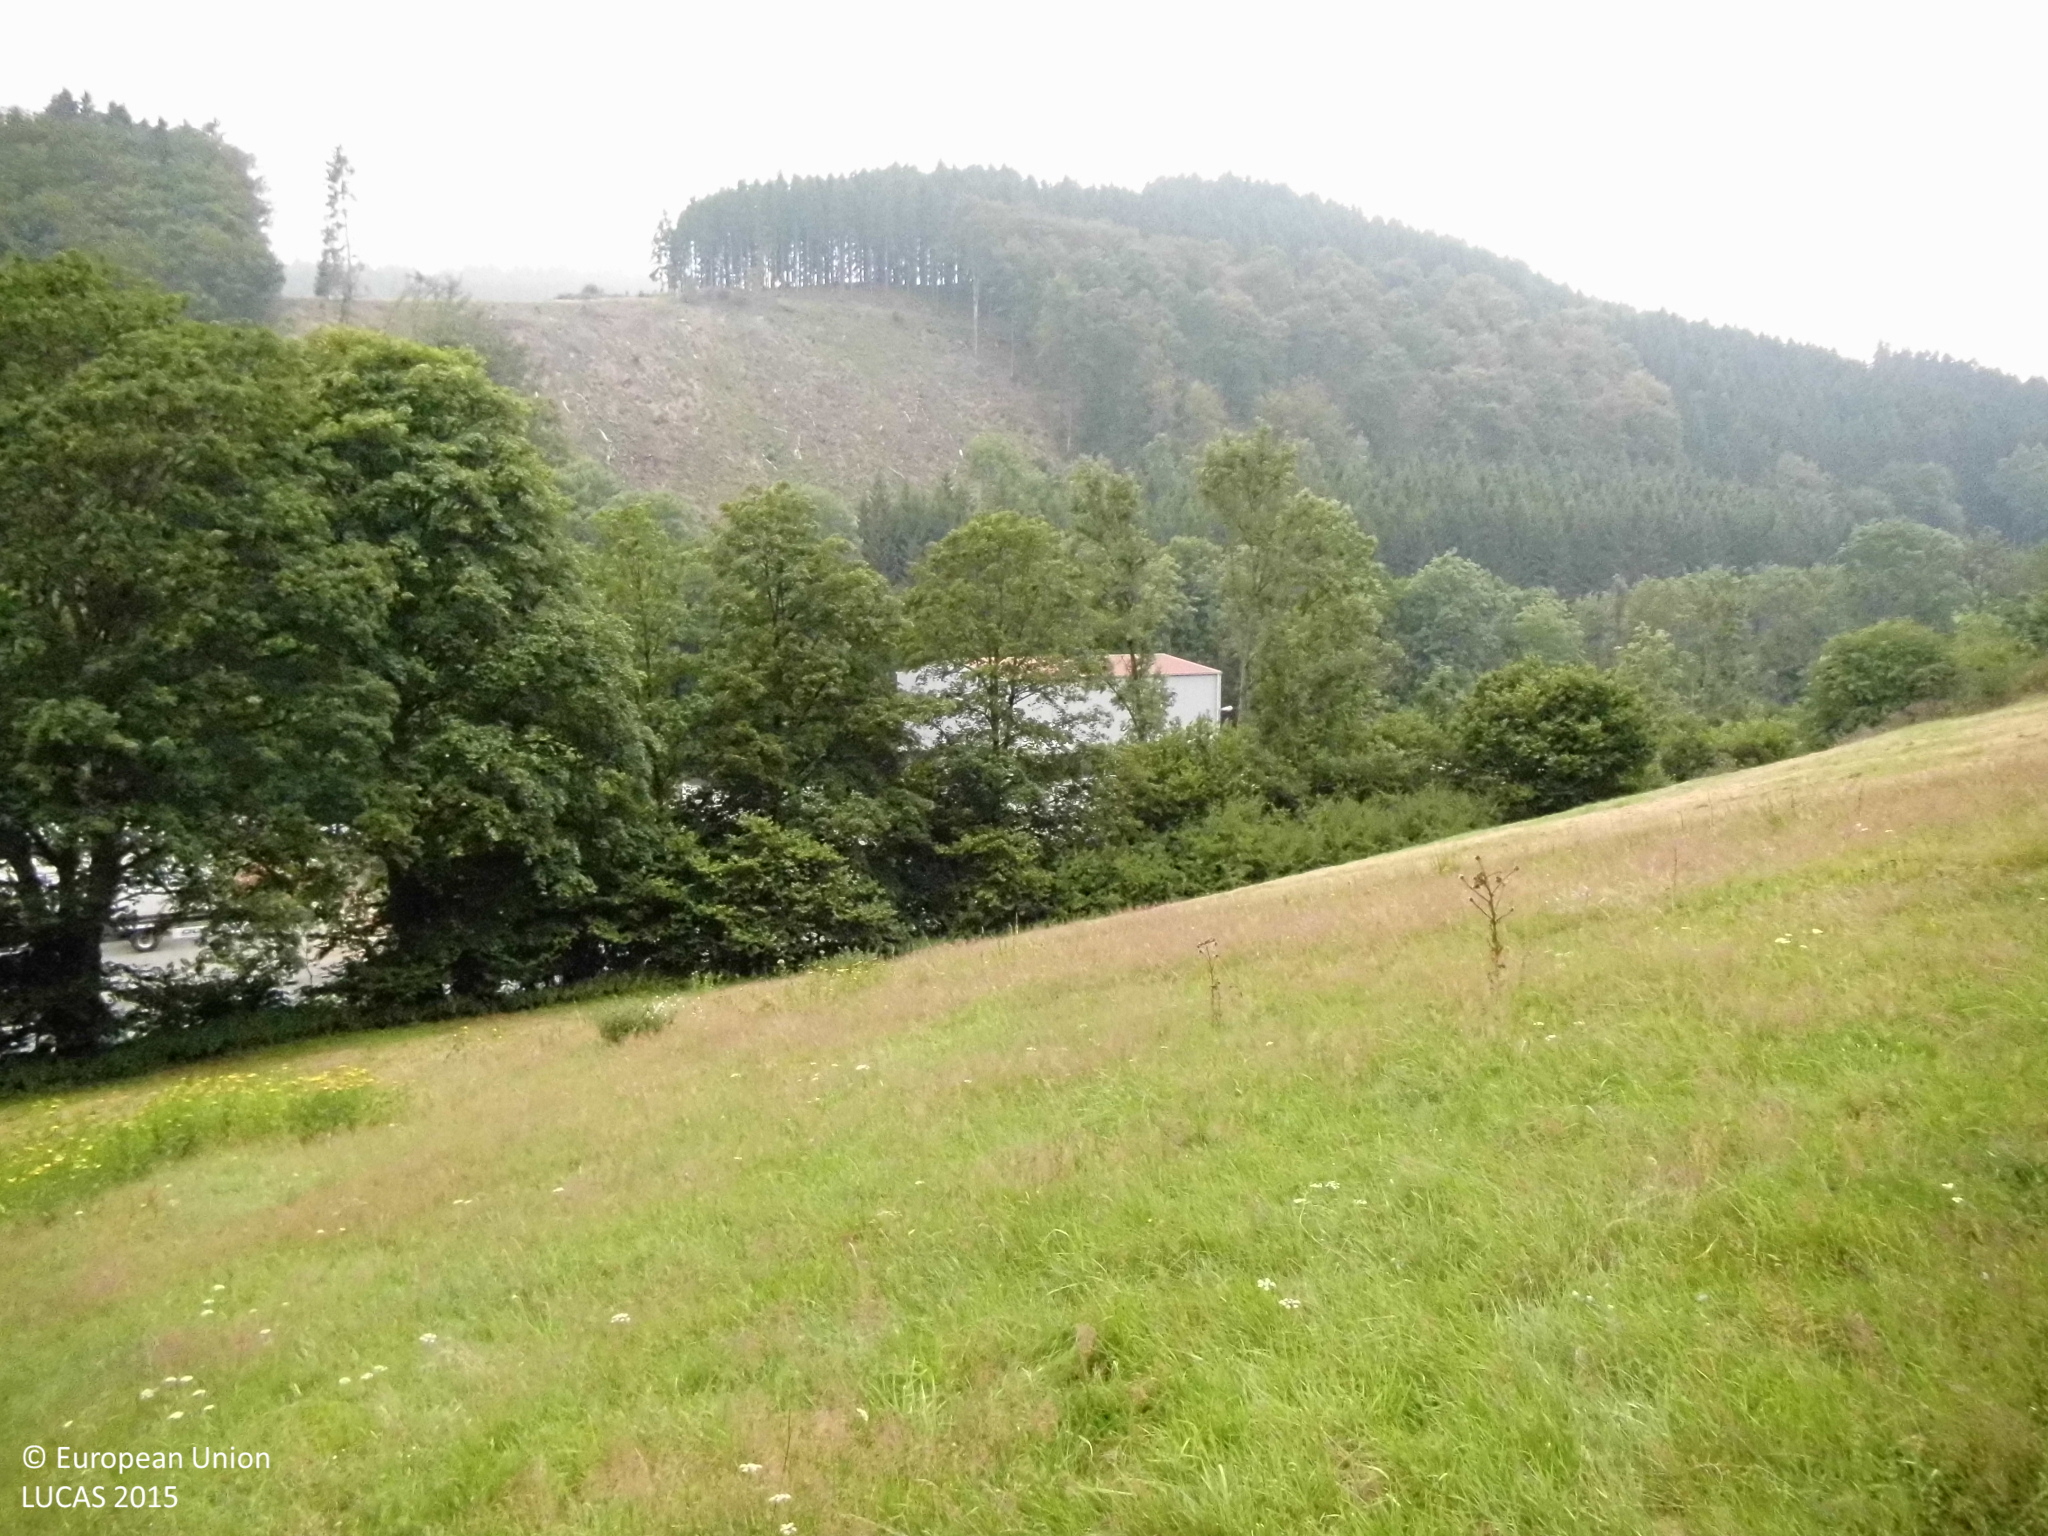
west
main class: Grassland
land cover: Grassland without tree/shrub cover
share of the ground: > 75 %
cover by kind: herbaceous plants 100 %
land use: Agriculture (excluding fallow land and kitchen gardens)
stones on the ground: 10 - 25 %
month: August
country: DE
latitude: 51.1465
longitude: 8.5852
